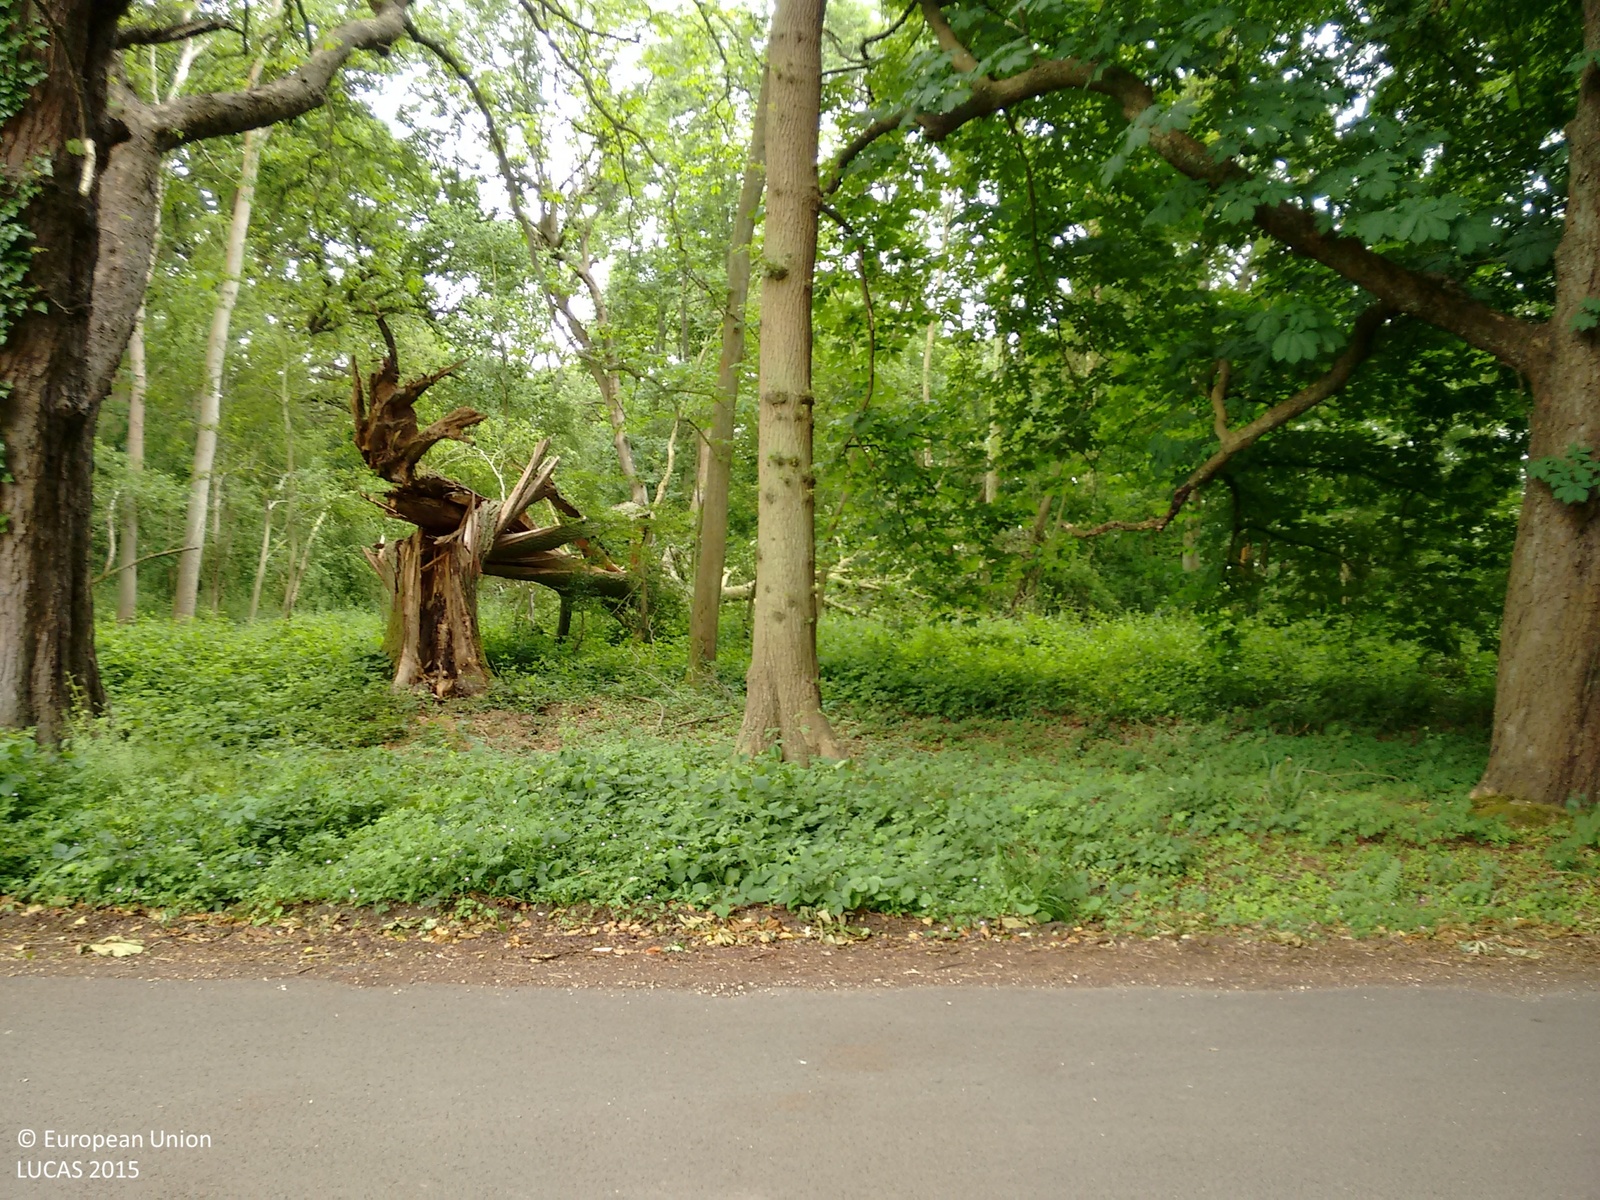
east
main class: Woodland
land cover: Broadleaved woodland
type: mesophytic deciduous forest
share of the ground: > 75 %
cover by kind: broadleaved forest trees 80 %, herbaceous plants 20 %
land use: Semi-natural and natural areas not in use
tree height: > 5 m
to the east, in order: Broadleaved woodland; Paved roads, cycling and walking lanes; Broadleaved woodland; Fences; Broadleaved woodland; Tracks; Grassland without tree/shrub cover; Single bushes/trees; Tracks
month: June
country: GB
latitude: 51.3890
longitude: -1.0384
